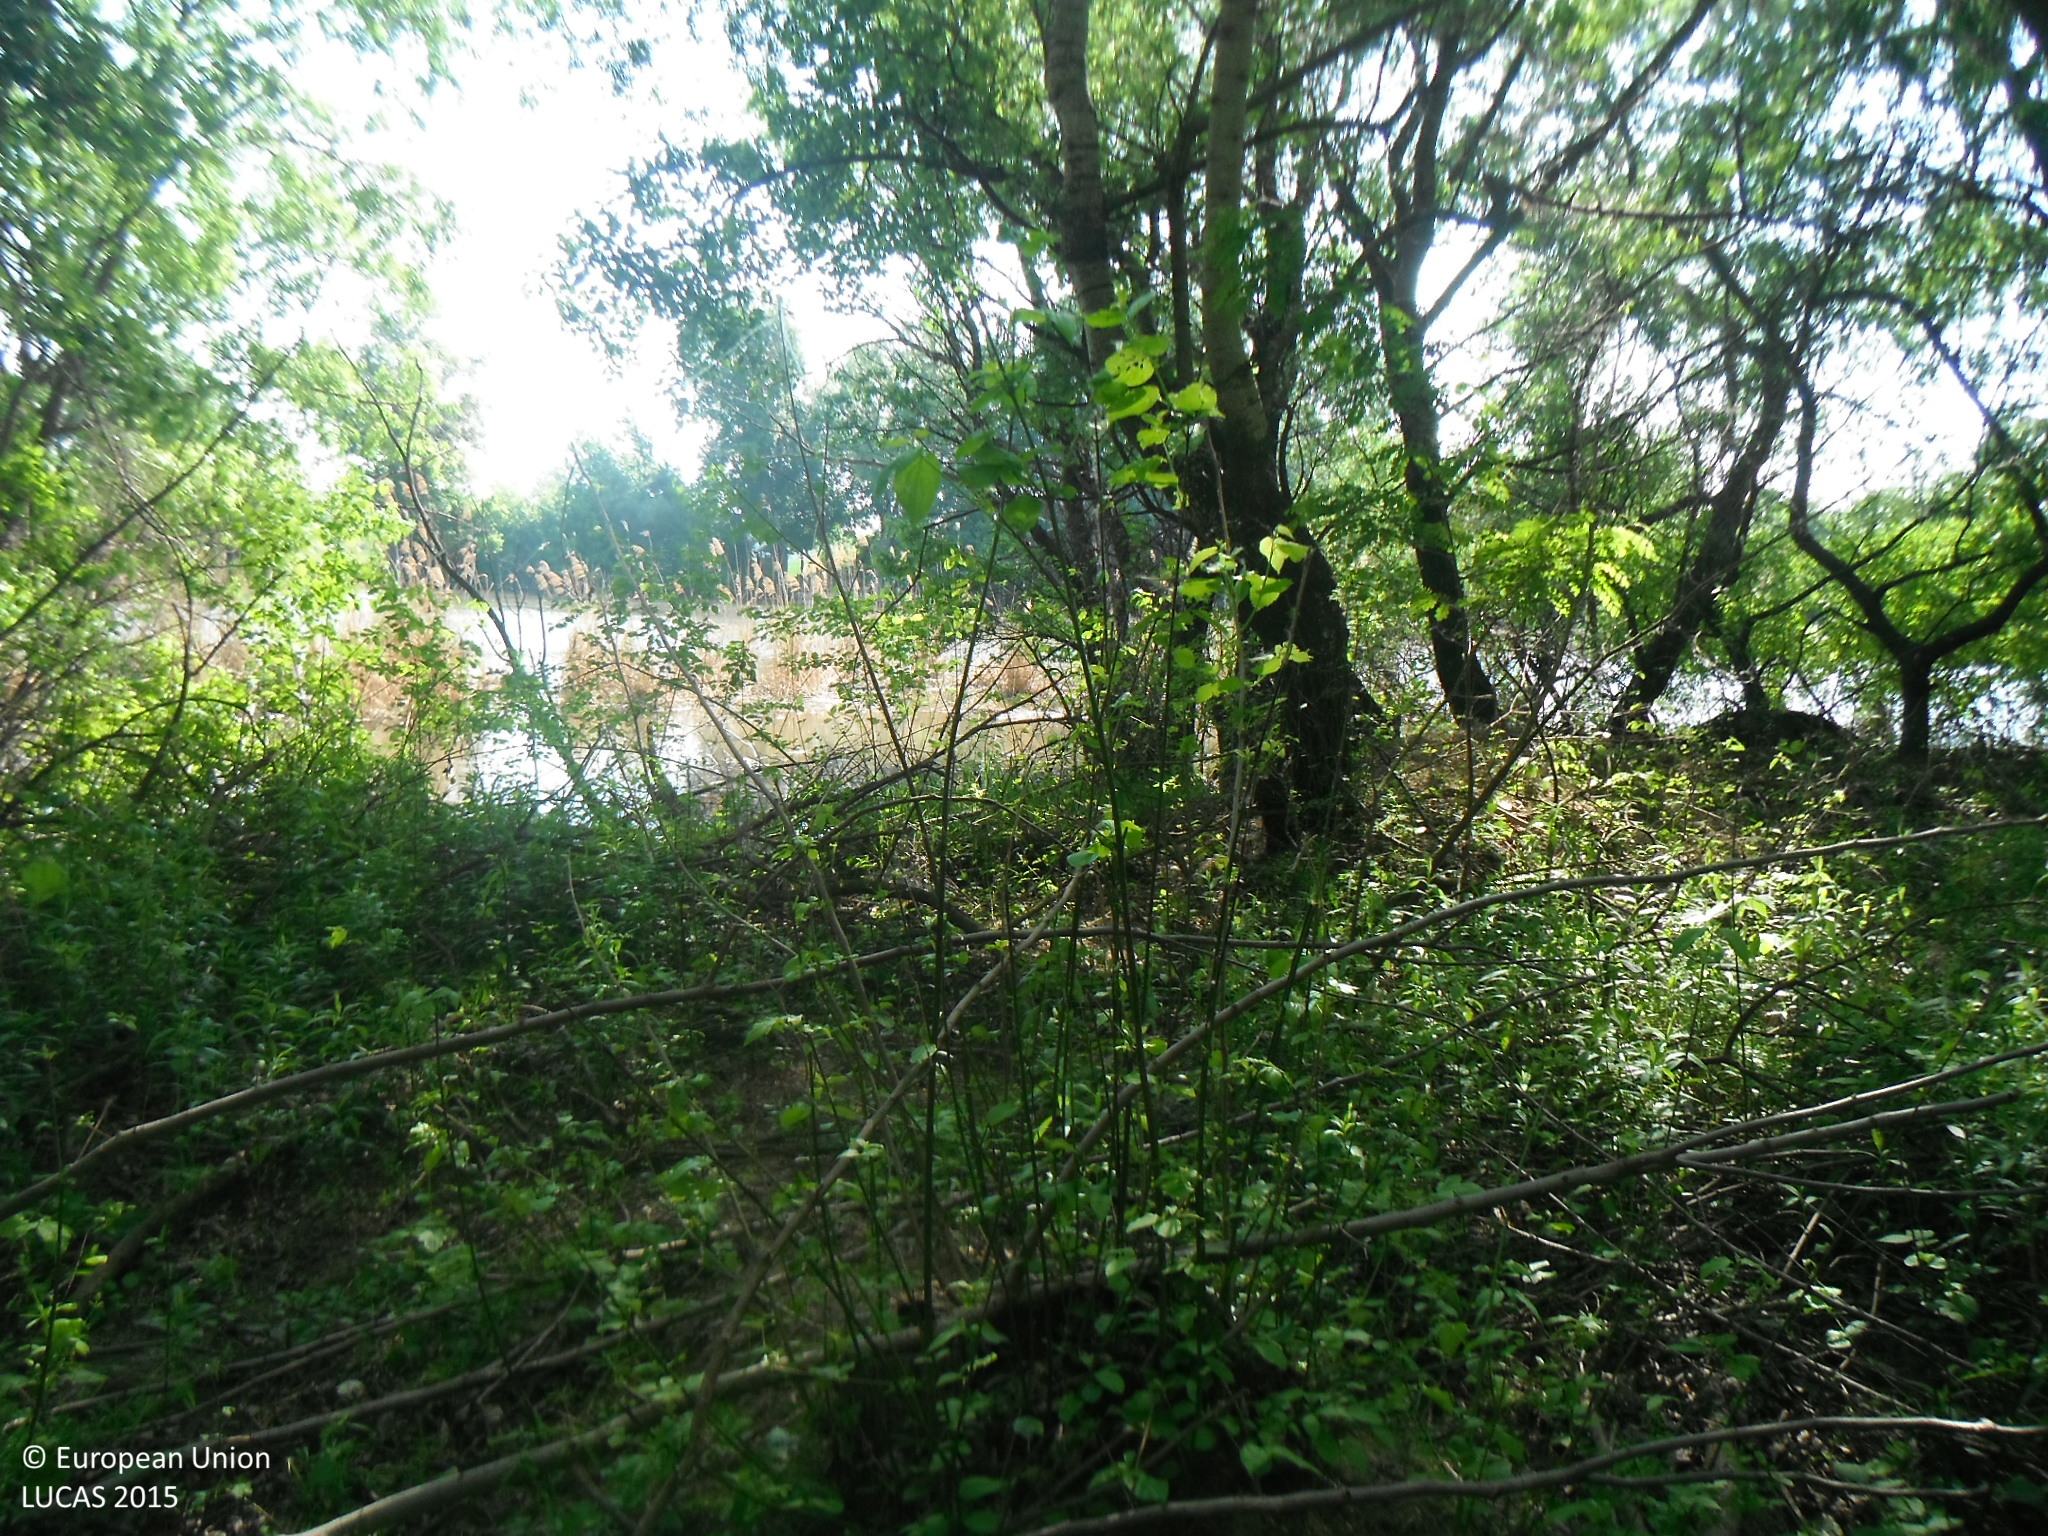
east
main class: Woodland
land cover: Broadleaved woodland
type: floodplain forest
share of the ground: > 75 %
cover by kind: broadleaved forest trees 80 %, shrubs 10 %, herbaceous plants 10 %
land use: Forestry
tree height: > 5 m
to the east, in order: Broadleaved woodland; Inland fresh running water; Broadleaved woodland; Tracks; Arable land (only in case pi); Artificial constructions in urban areas
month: May
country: SK
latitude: 48.0860
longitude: 17.6222
